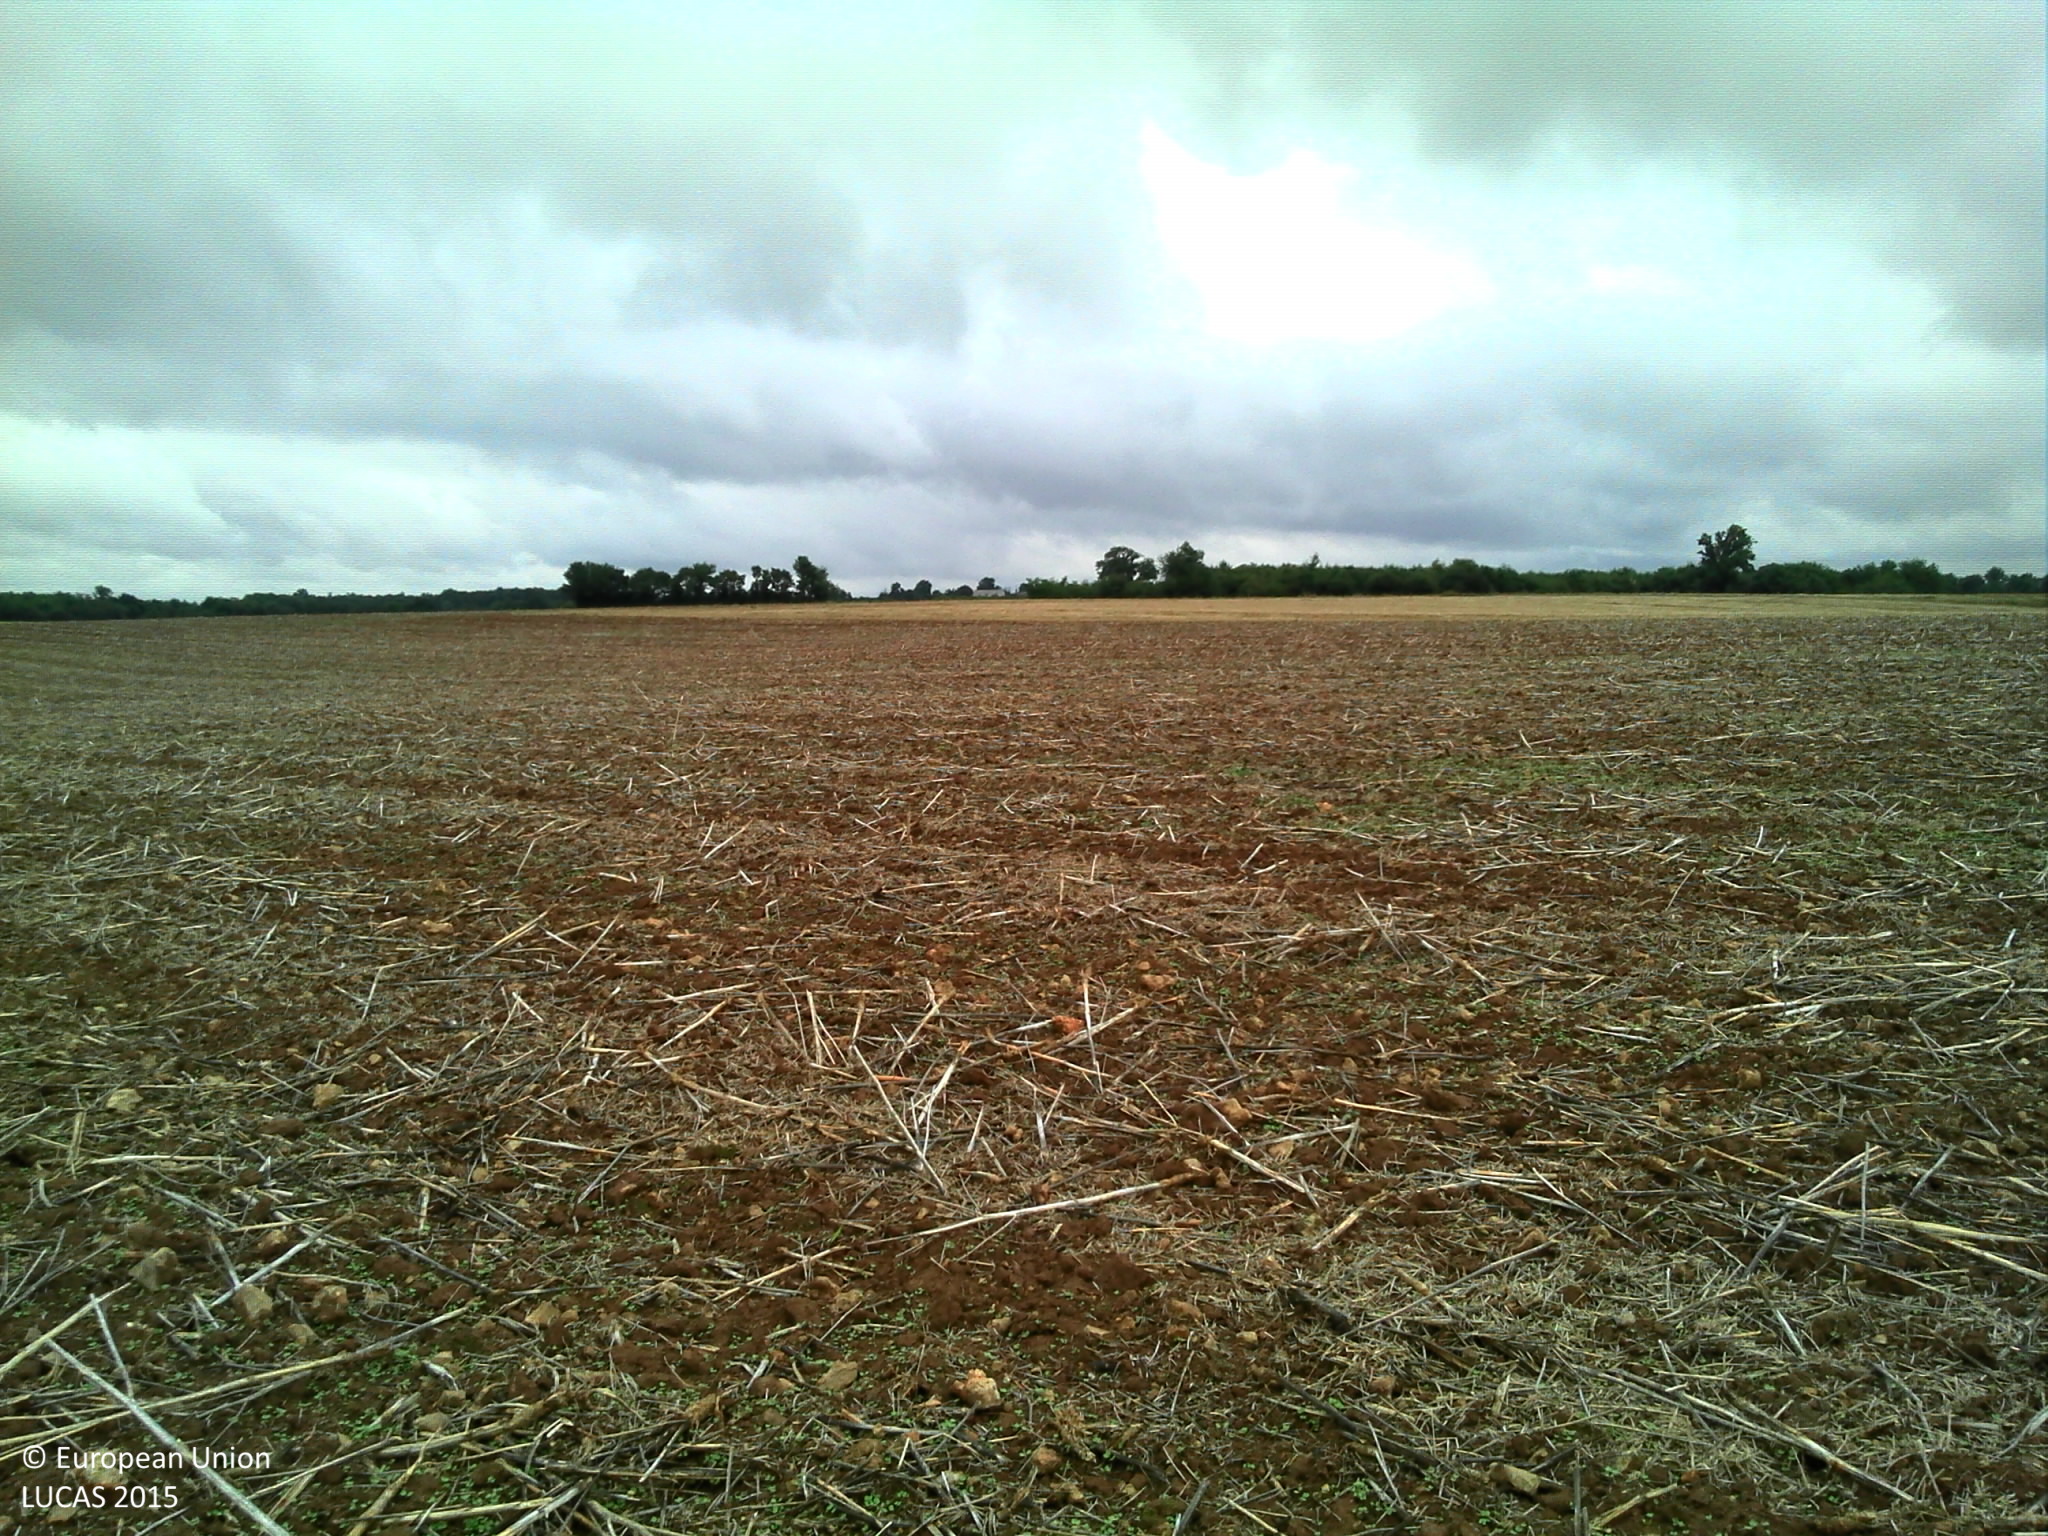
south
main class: Cropland
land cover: Rape and turnip rape
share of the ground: < 10 %
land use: Agriculture (excluding fallow land and kitchen gardens)
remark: Tilled/Sowed
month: August
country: FR
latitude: 46.0701
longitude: 0.2731
